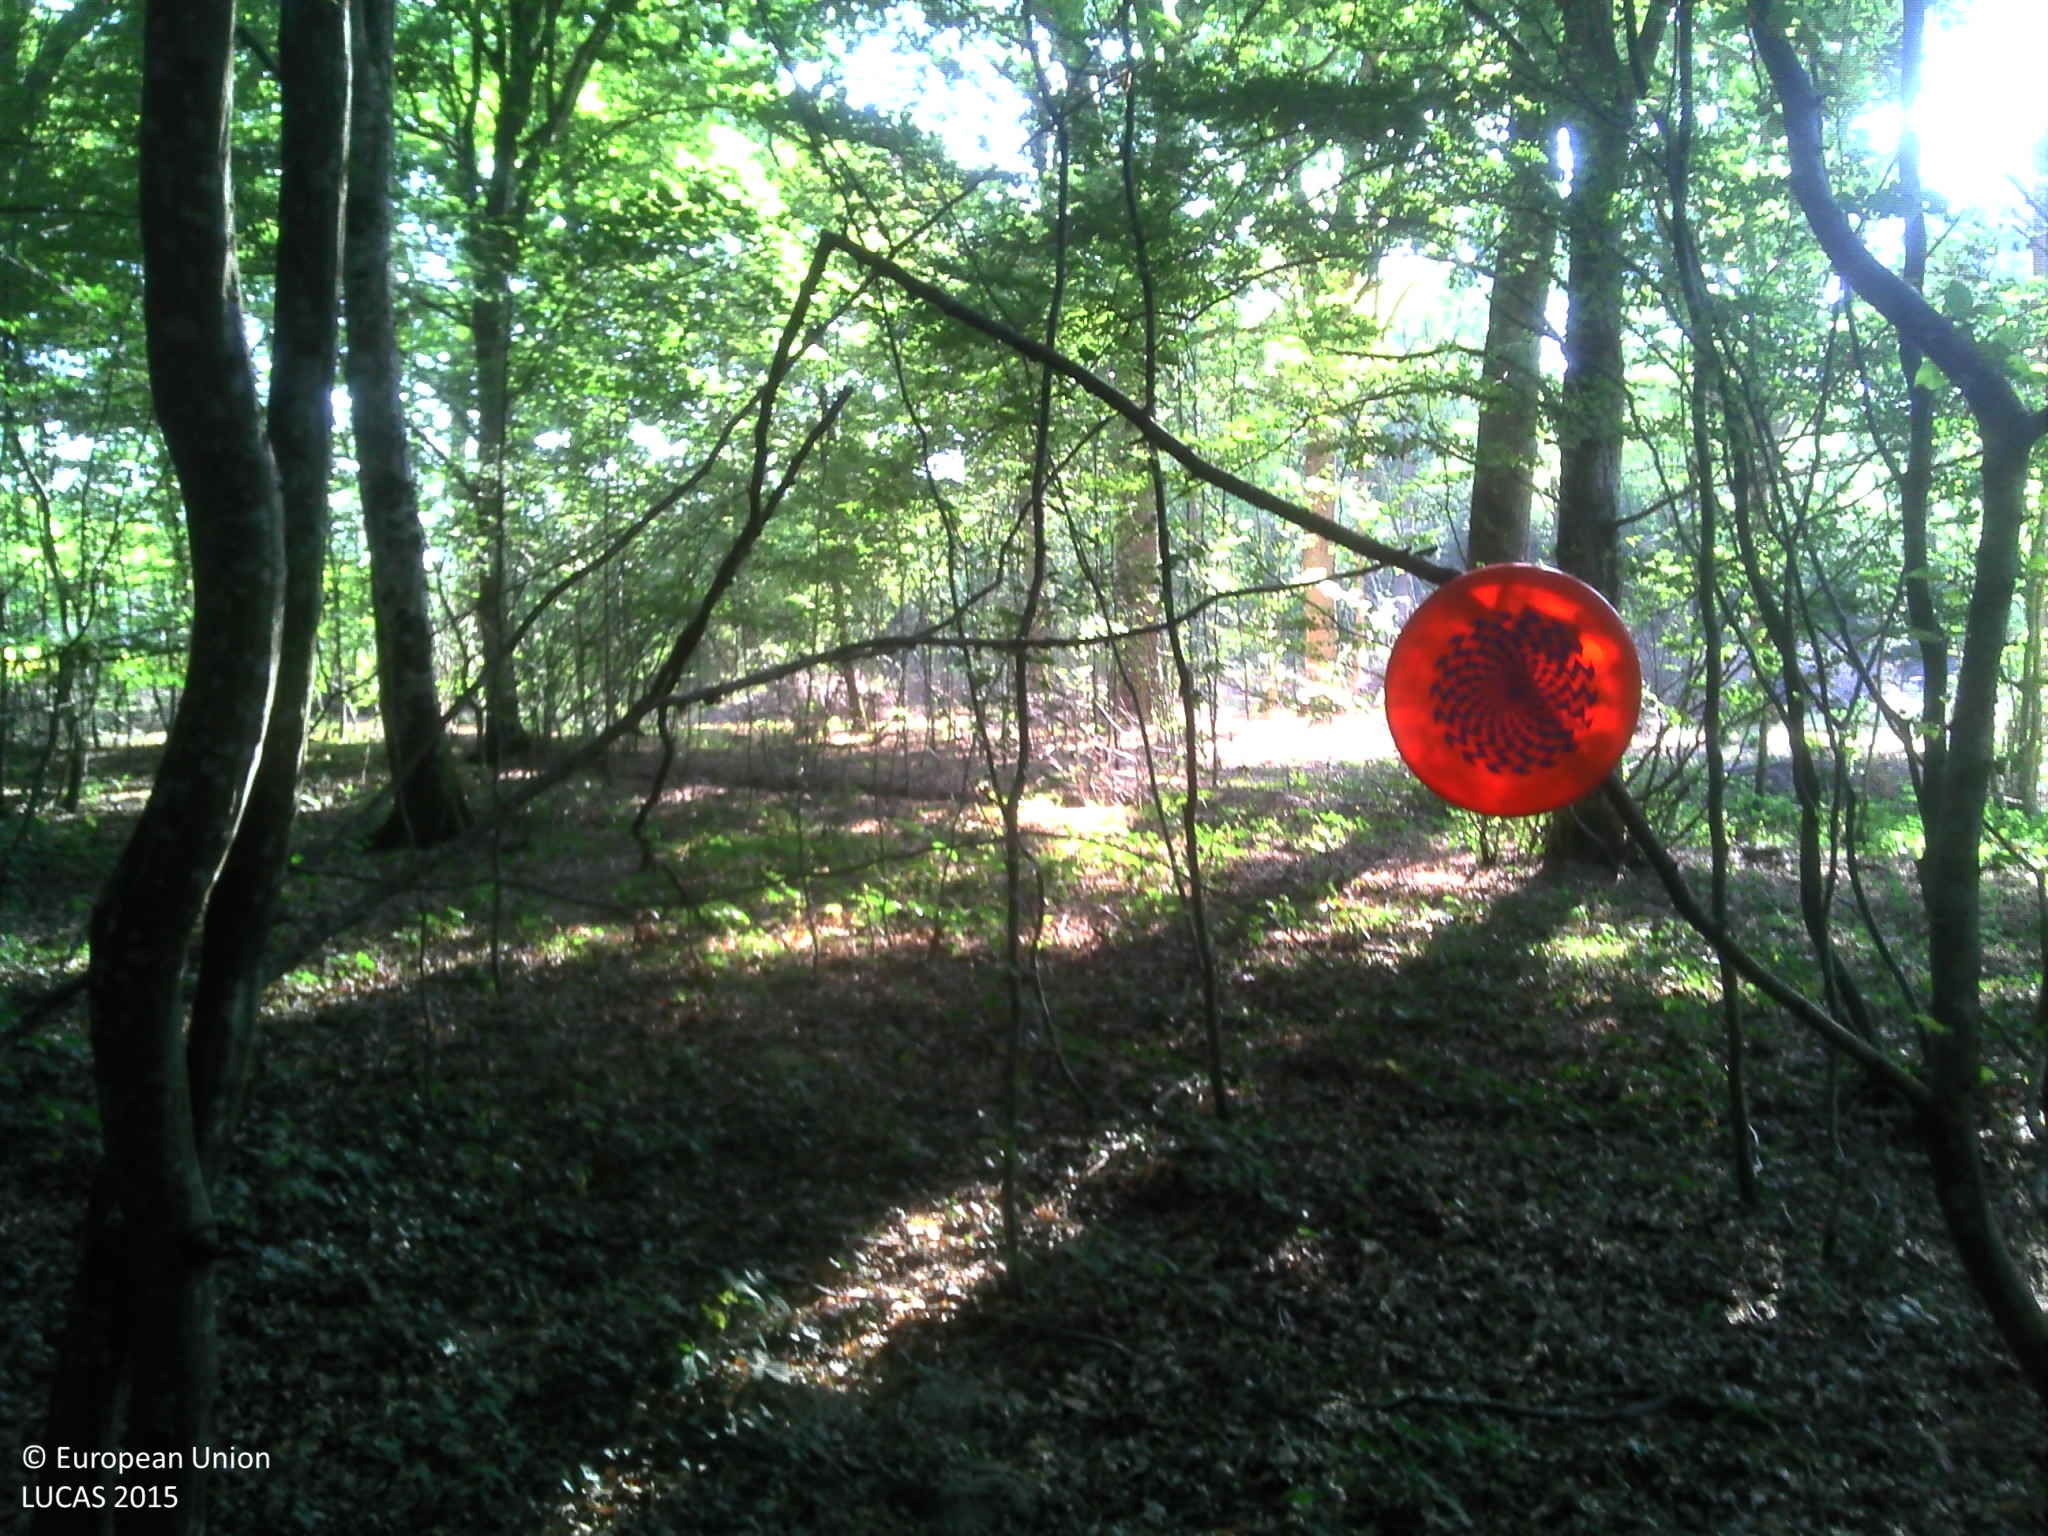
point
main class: Woodland
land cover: Broadleaved woodland
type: mesophytic deciduous forest
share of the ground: > 75 %
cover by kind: broadleaved forest trees 80 %, herbaceous plants 20 %
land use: Forestry
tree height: > 5 m
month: July
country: FR
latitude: 46.7797
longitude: 5.0901
